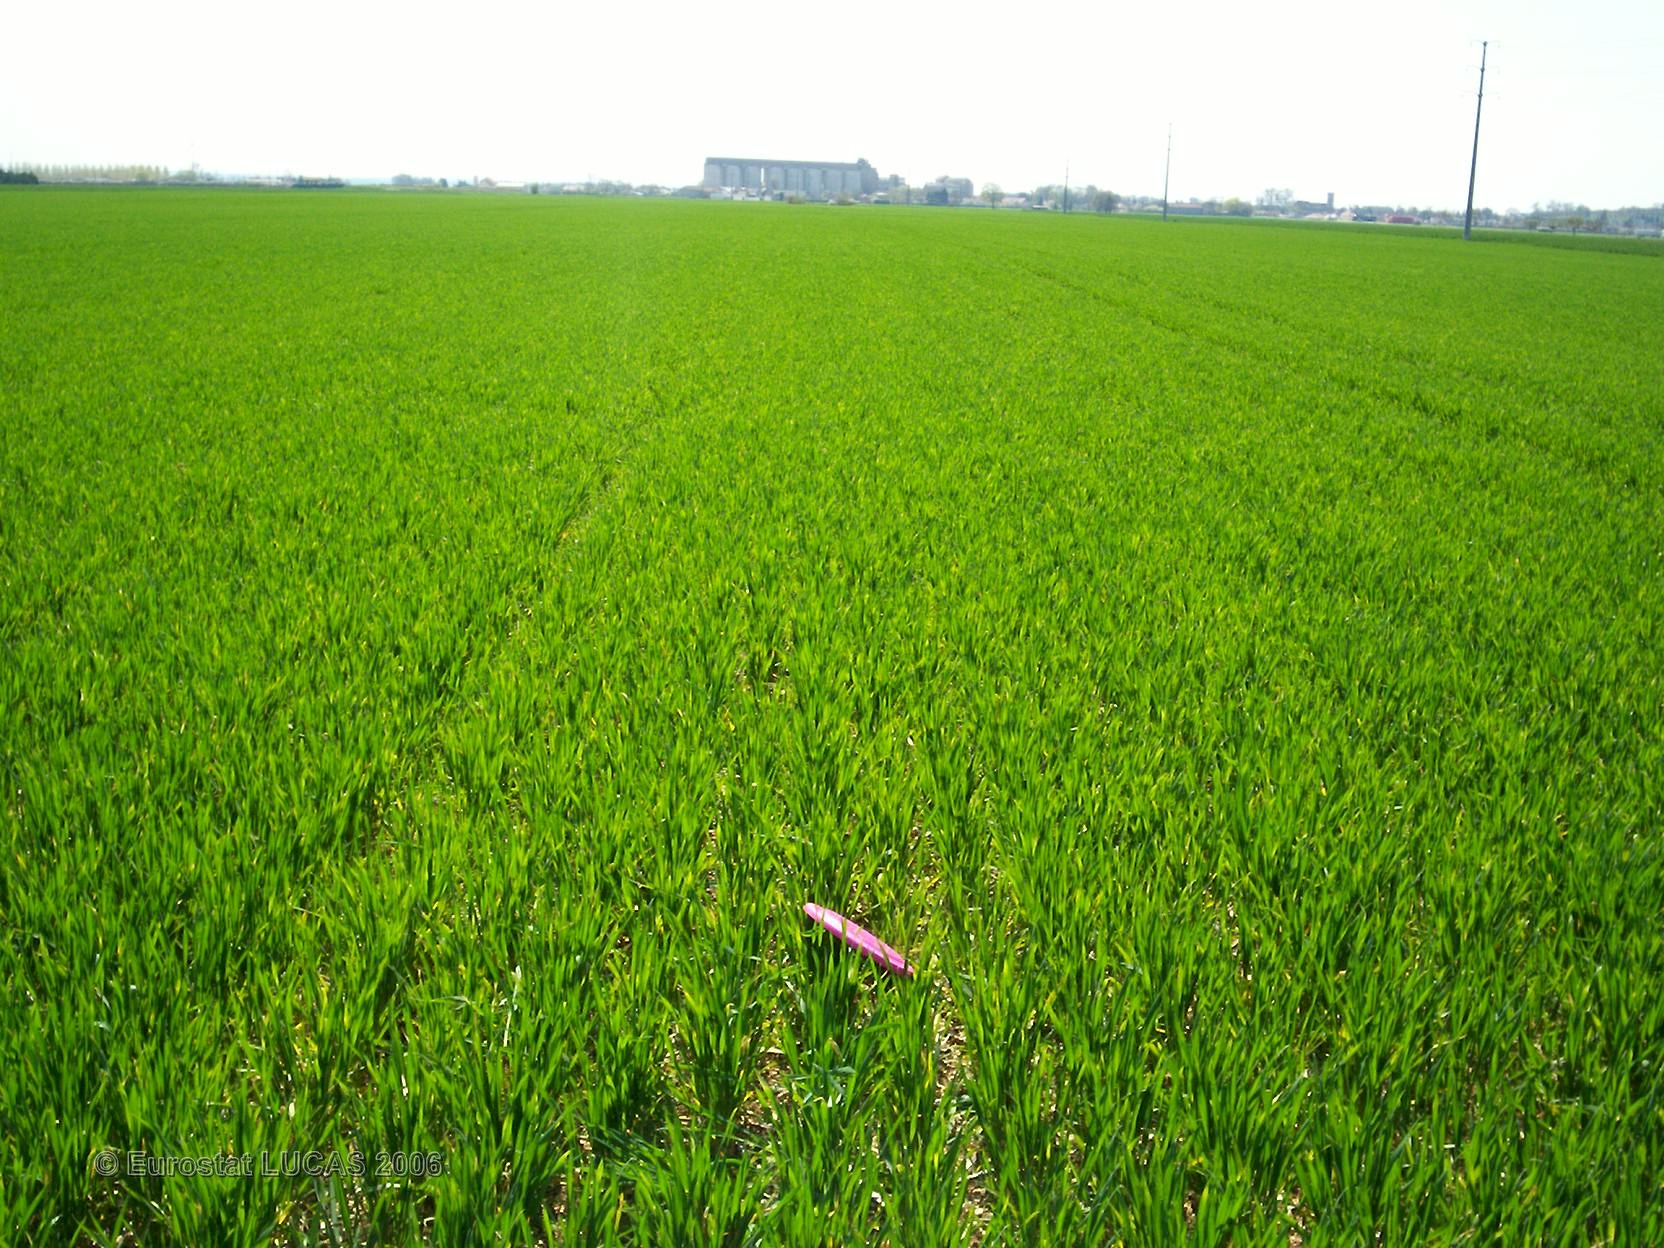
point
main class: Cropland
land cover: Common wheat
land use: Agriculture (excluding fallow land and kitchen gardens)
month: April
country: FR
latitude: 48.4122
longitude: 4.5257
